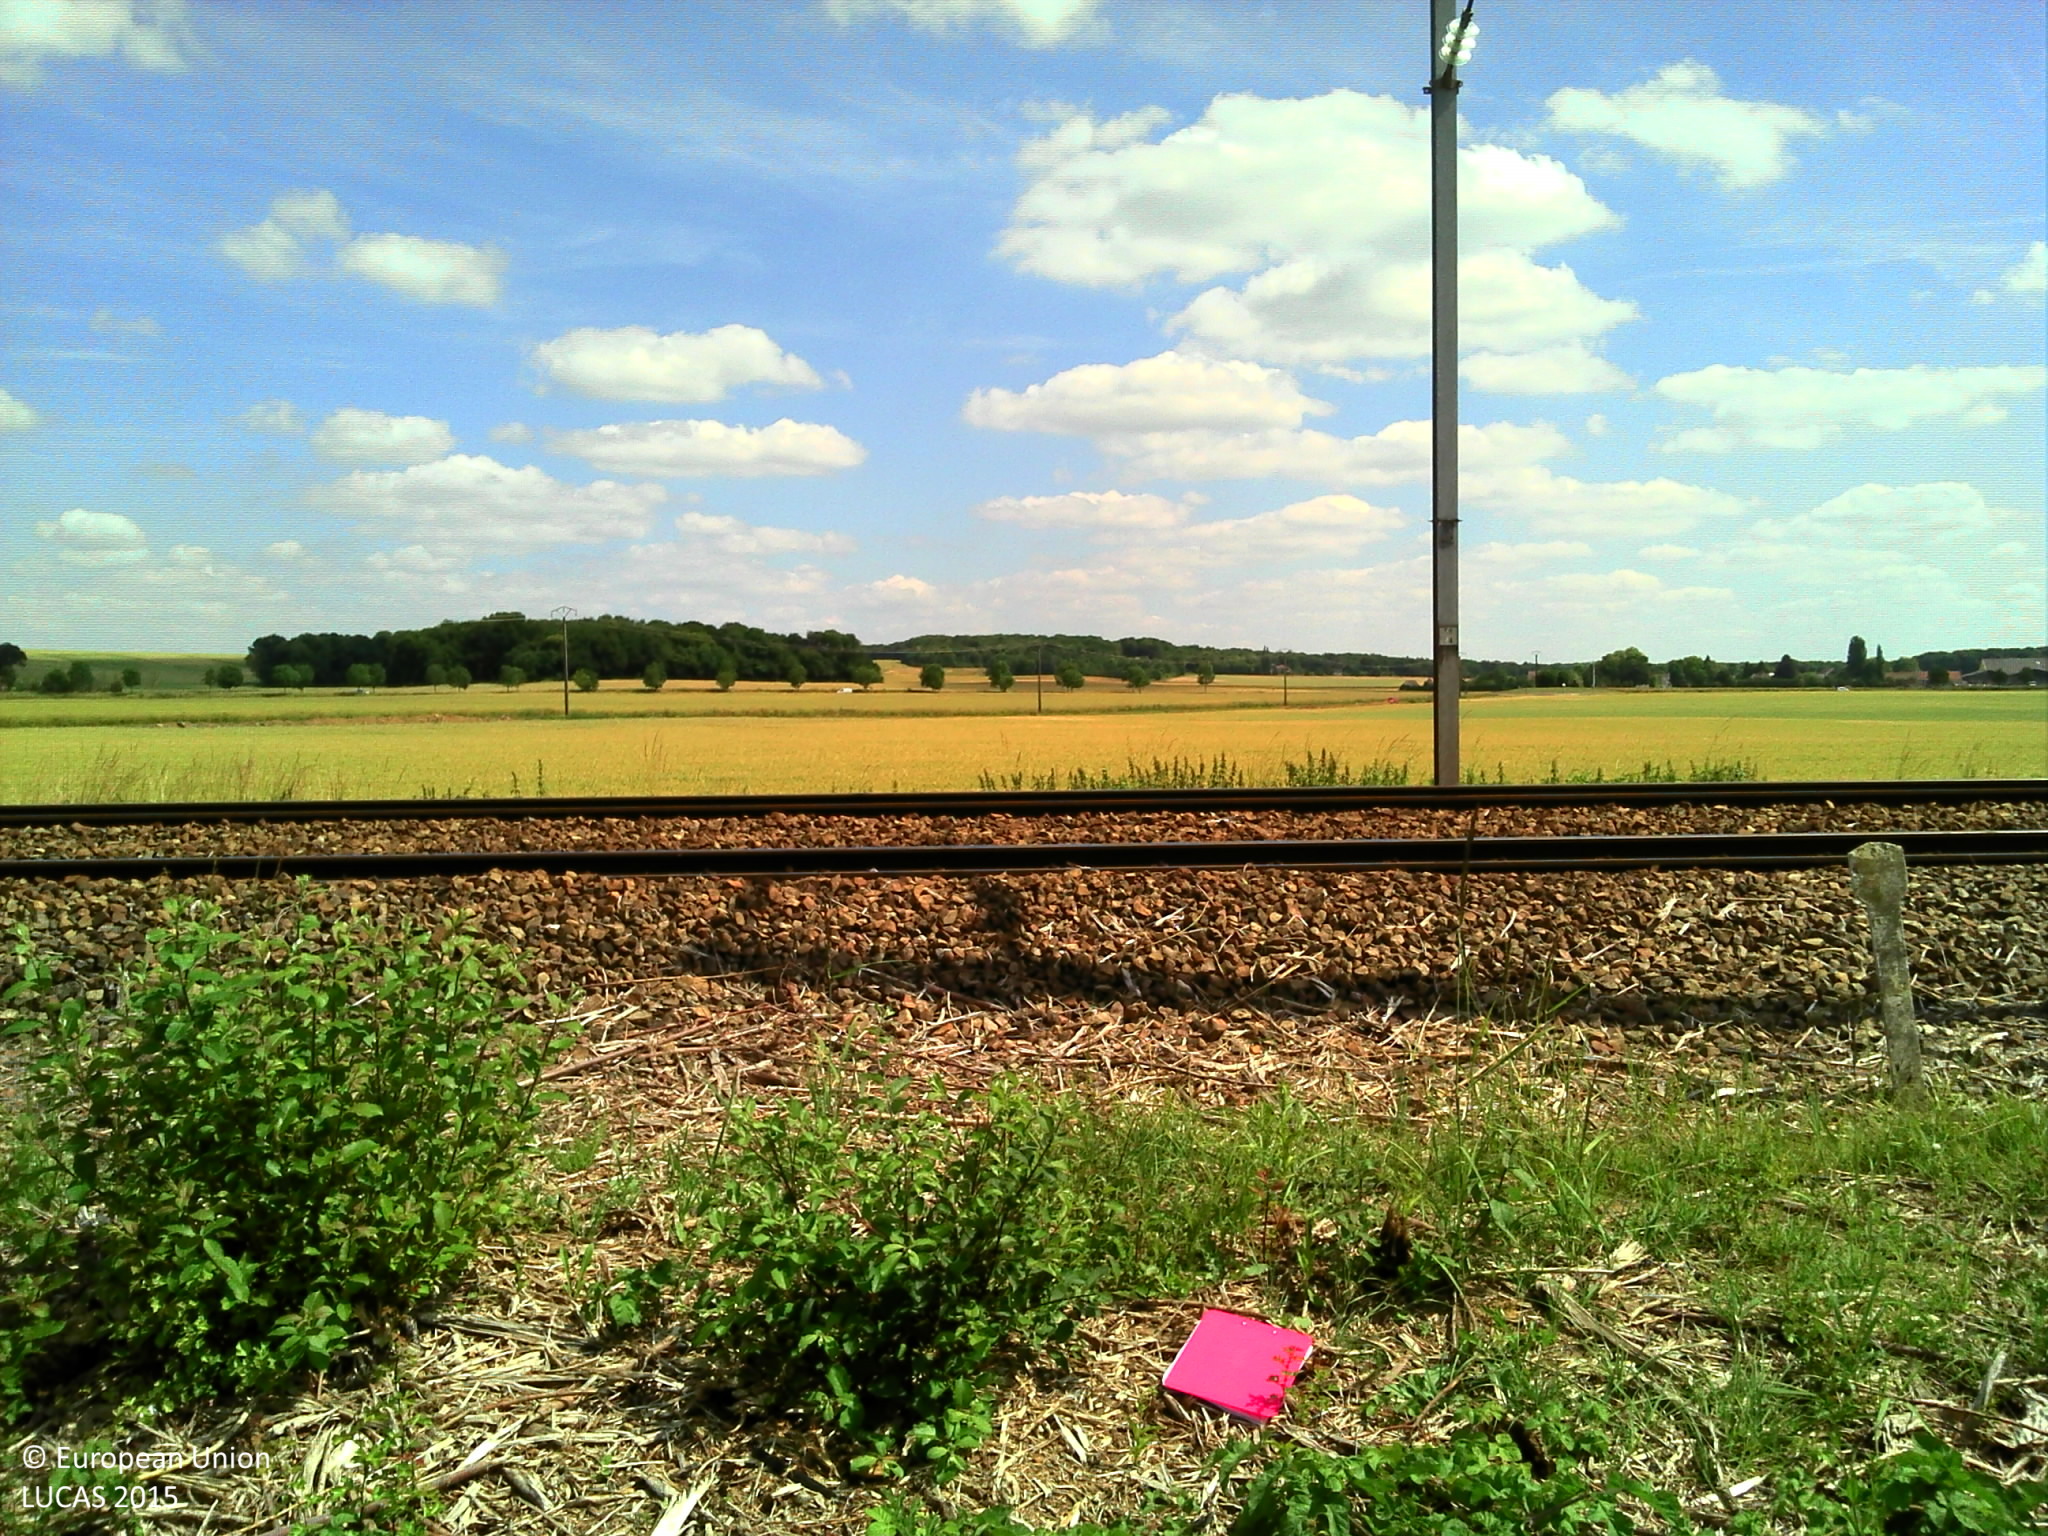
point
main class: Grassland
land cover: Spontaneously vegetated surfaces
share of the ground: > 75 %
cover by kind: herbaceous plants 85 %, unconsolidated bare surface 10 %, shrubs 5 %
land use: Semi-natural and natural areas not in use
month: June
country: FR
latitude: 49.2203
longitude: 2.8645
